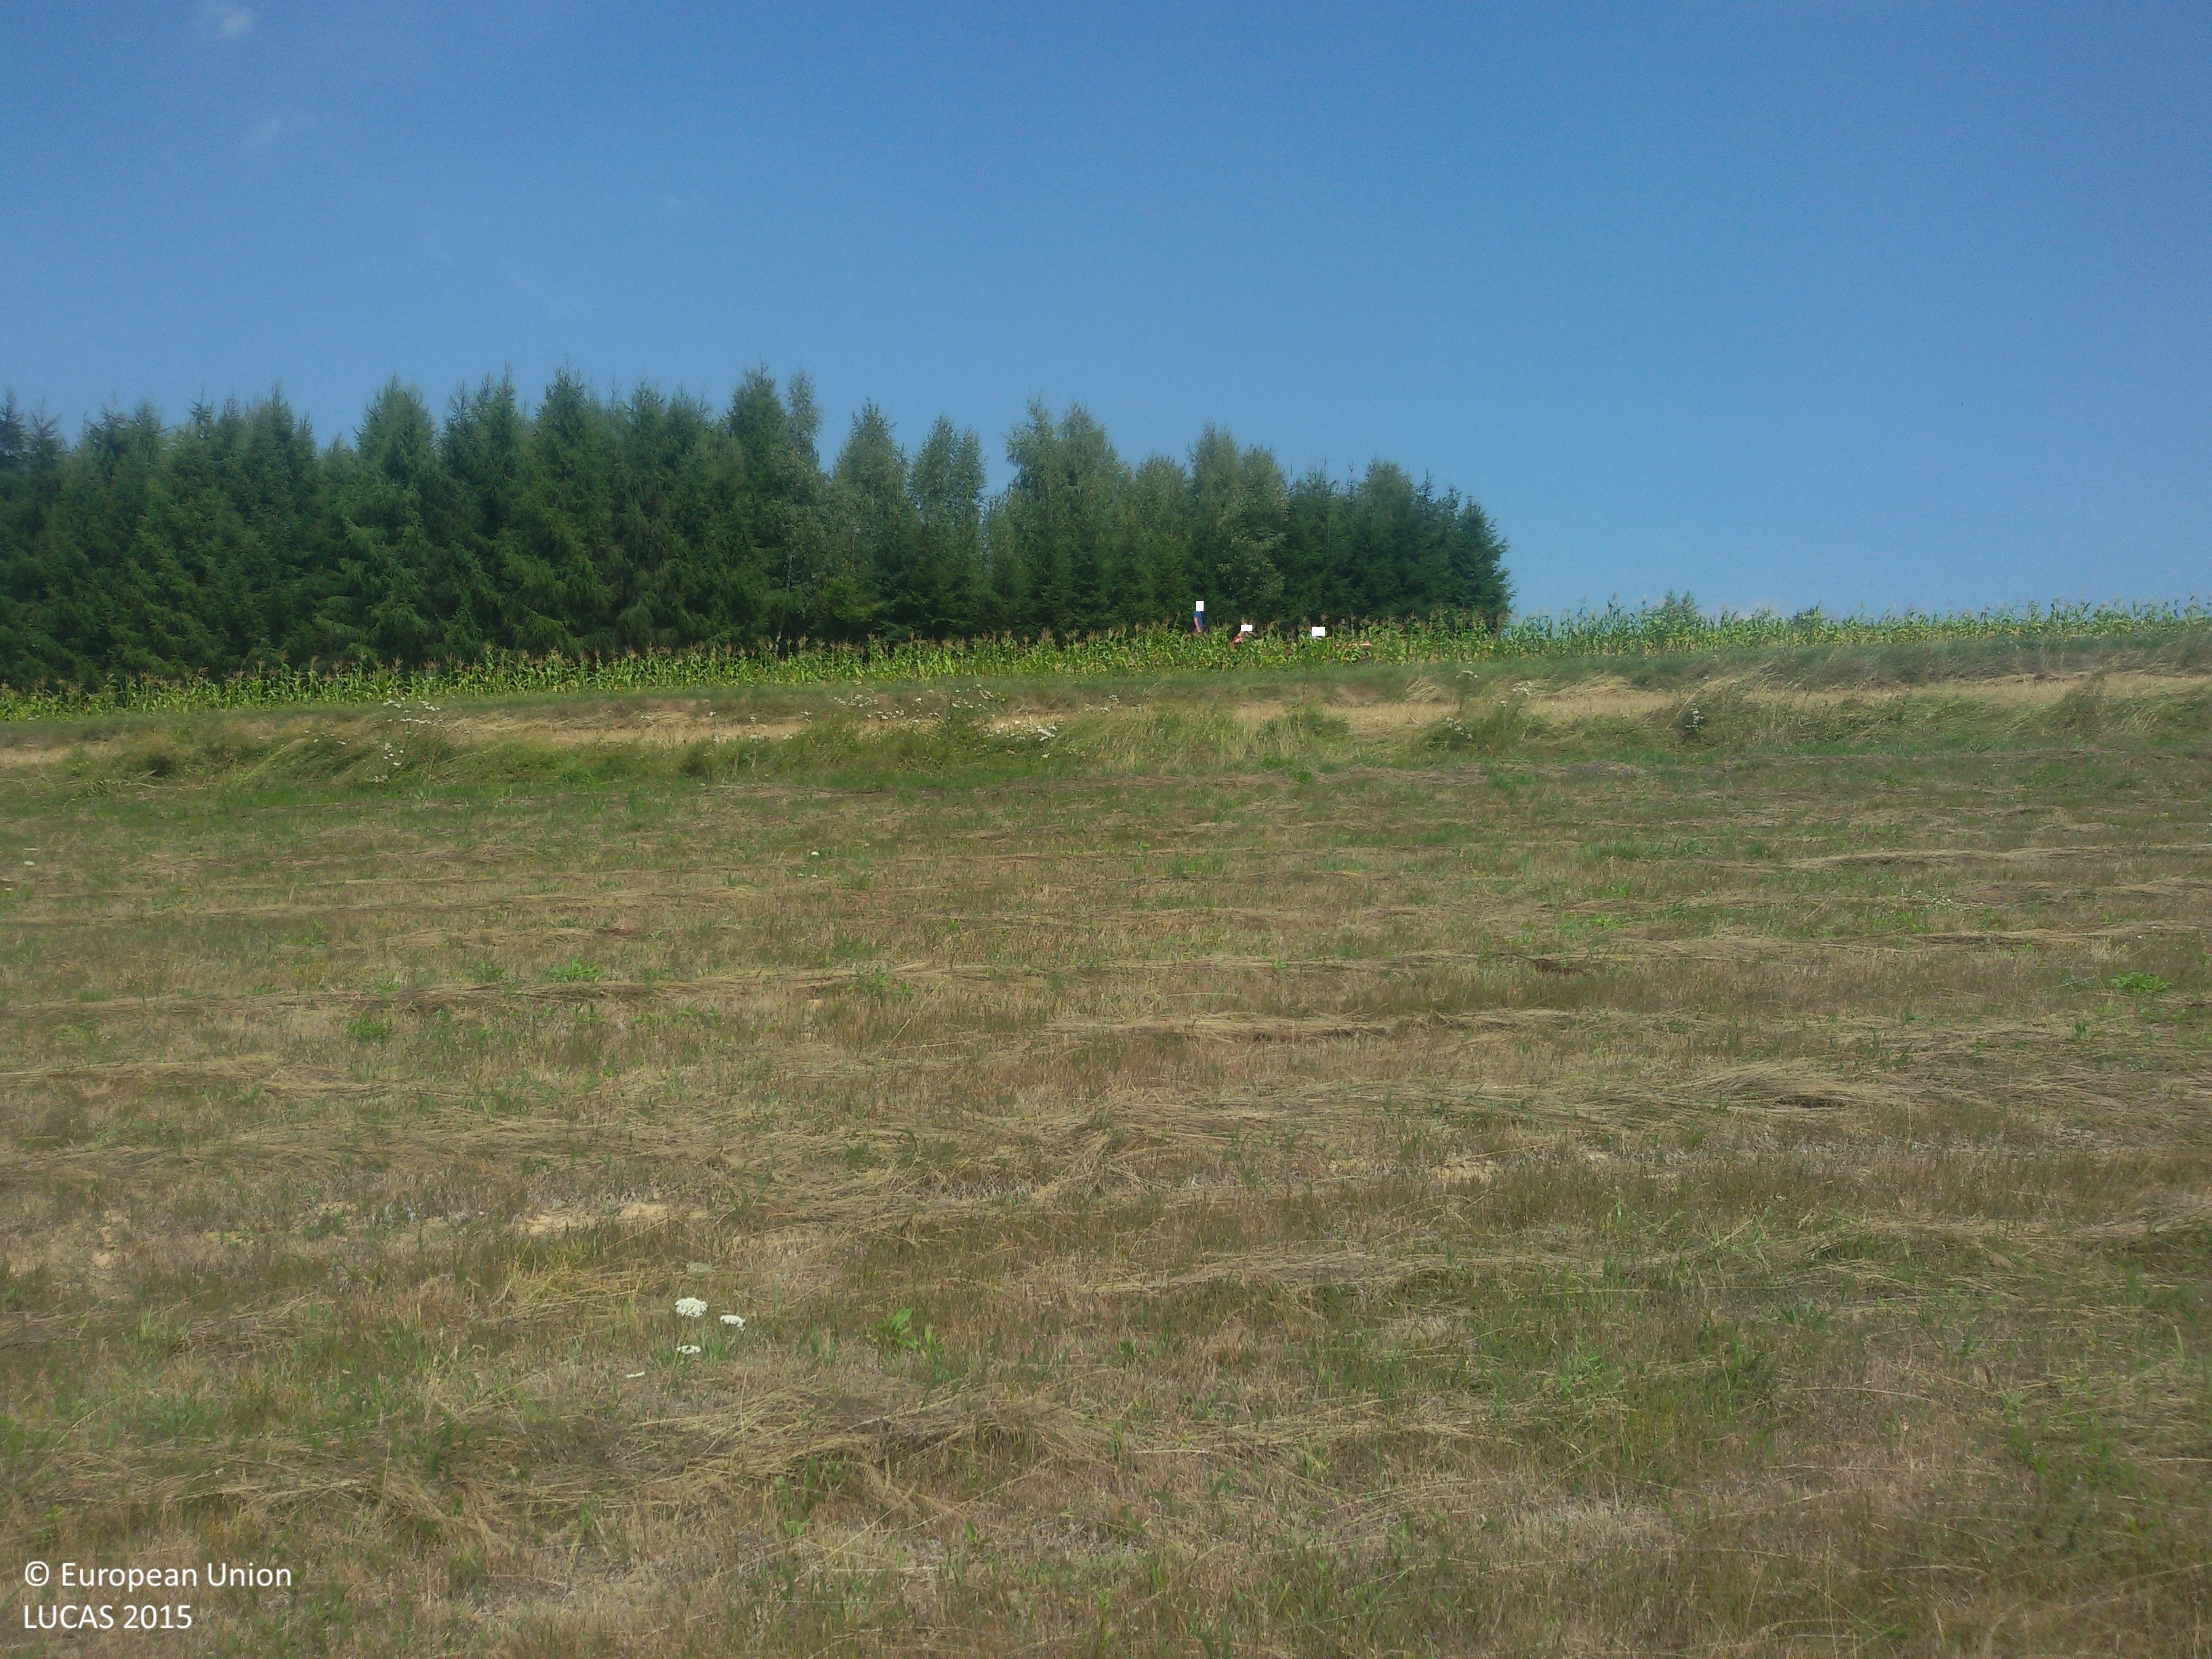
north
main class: Grassland
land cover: Grassland without tree/shrub cover
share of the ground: > 75 %
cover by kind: herbaceous plants 100 %
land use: Agriculture (excluding fallow land and kitchen gardens)
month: July
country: PL
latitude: 49.8801
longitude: 20.6857
